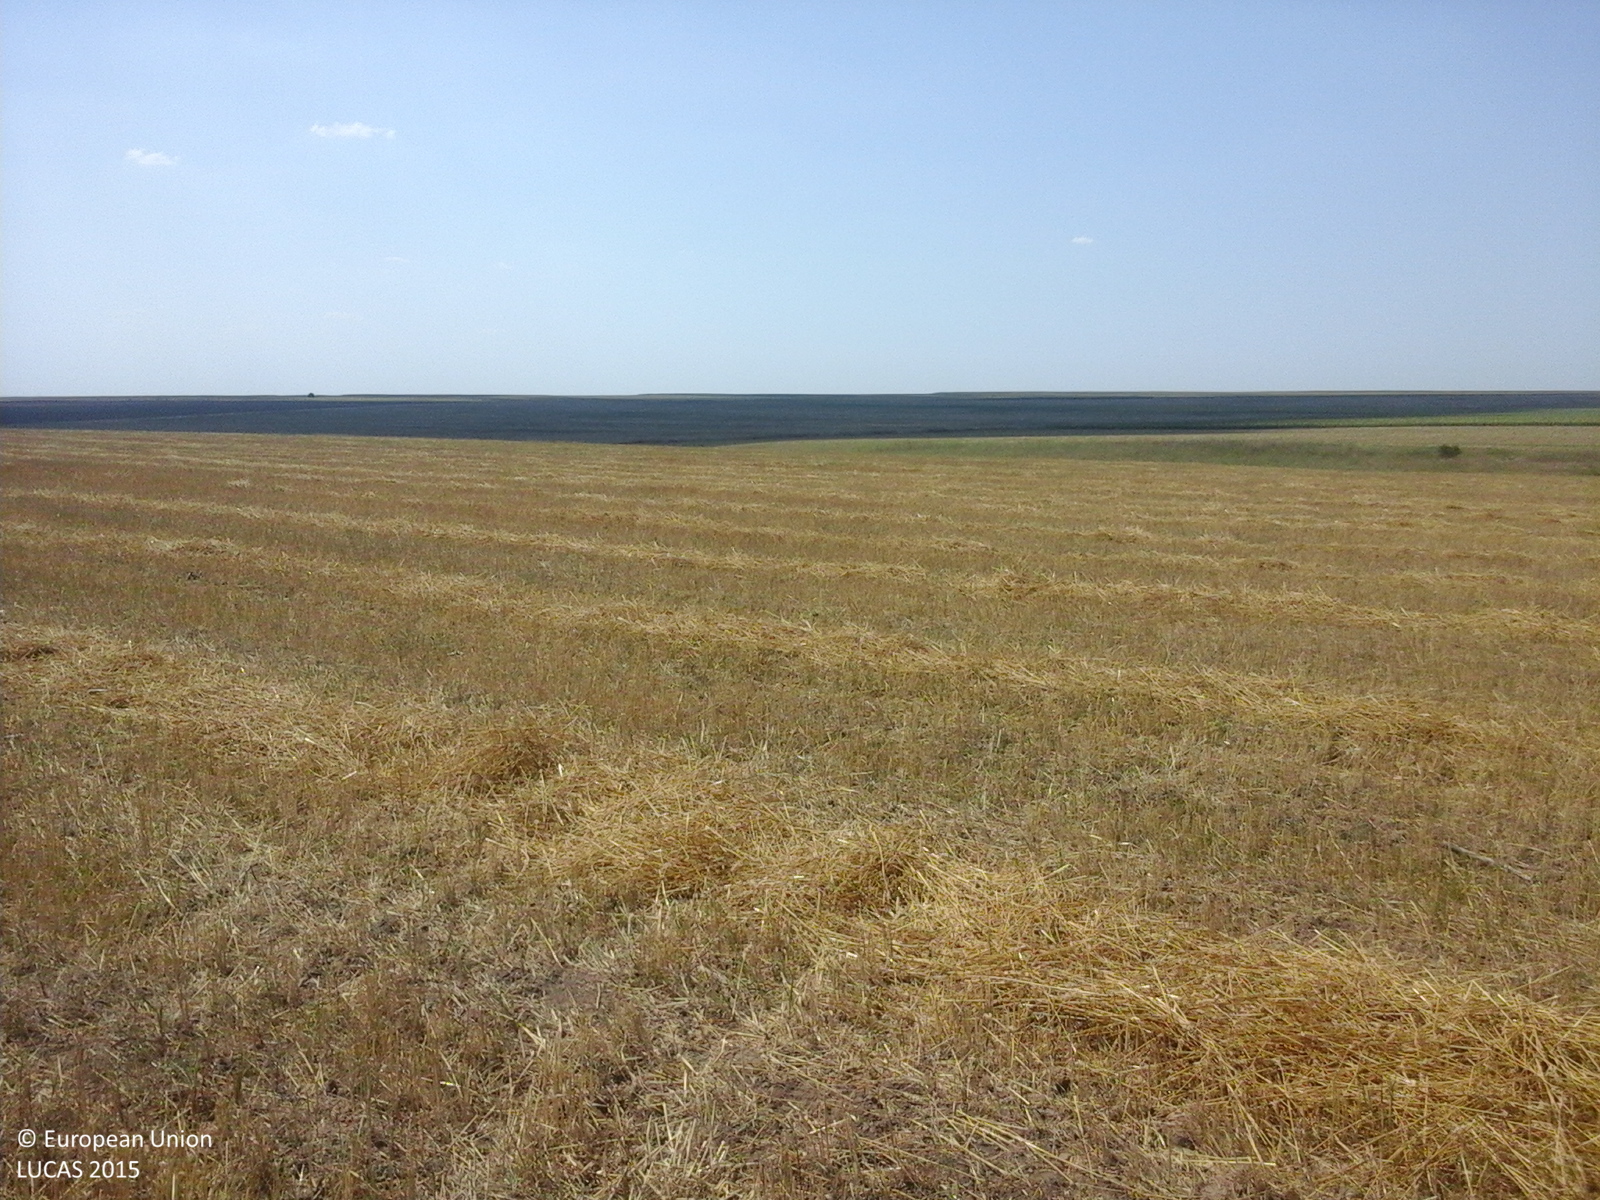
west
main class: Cropland
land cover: Common wheat
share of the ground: > 75 %
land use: Agriculture (excluding fallow land and kitchen gardens)
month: August
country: RO
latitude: 44.5288
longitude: 28.1181
